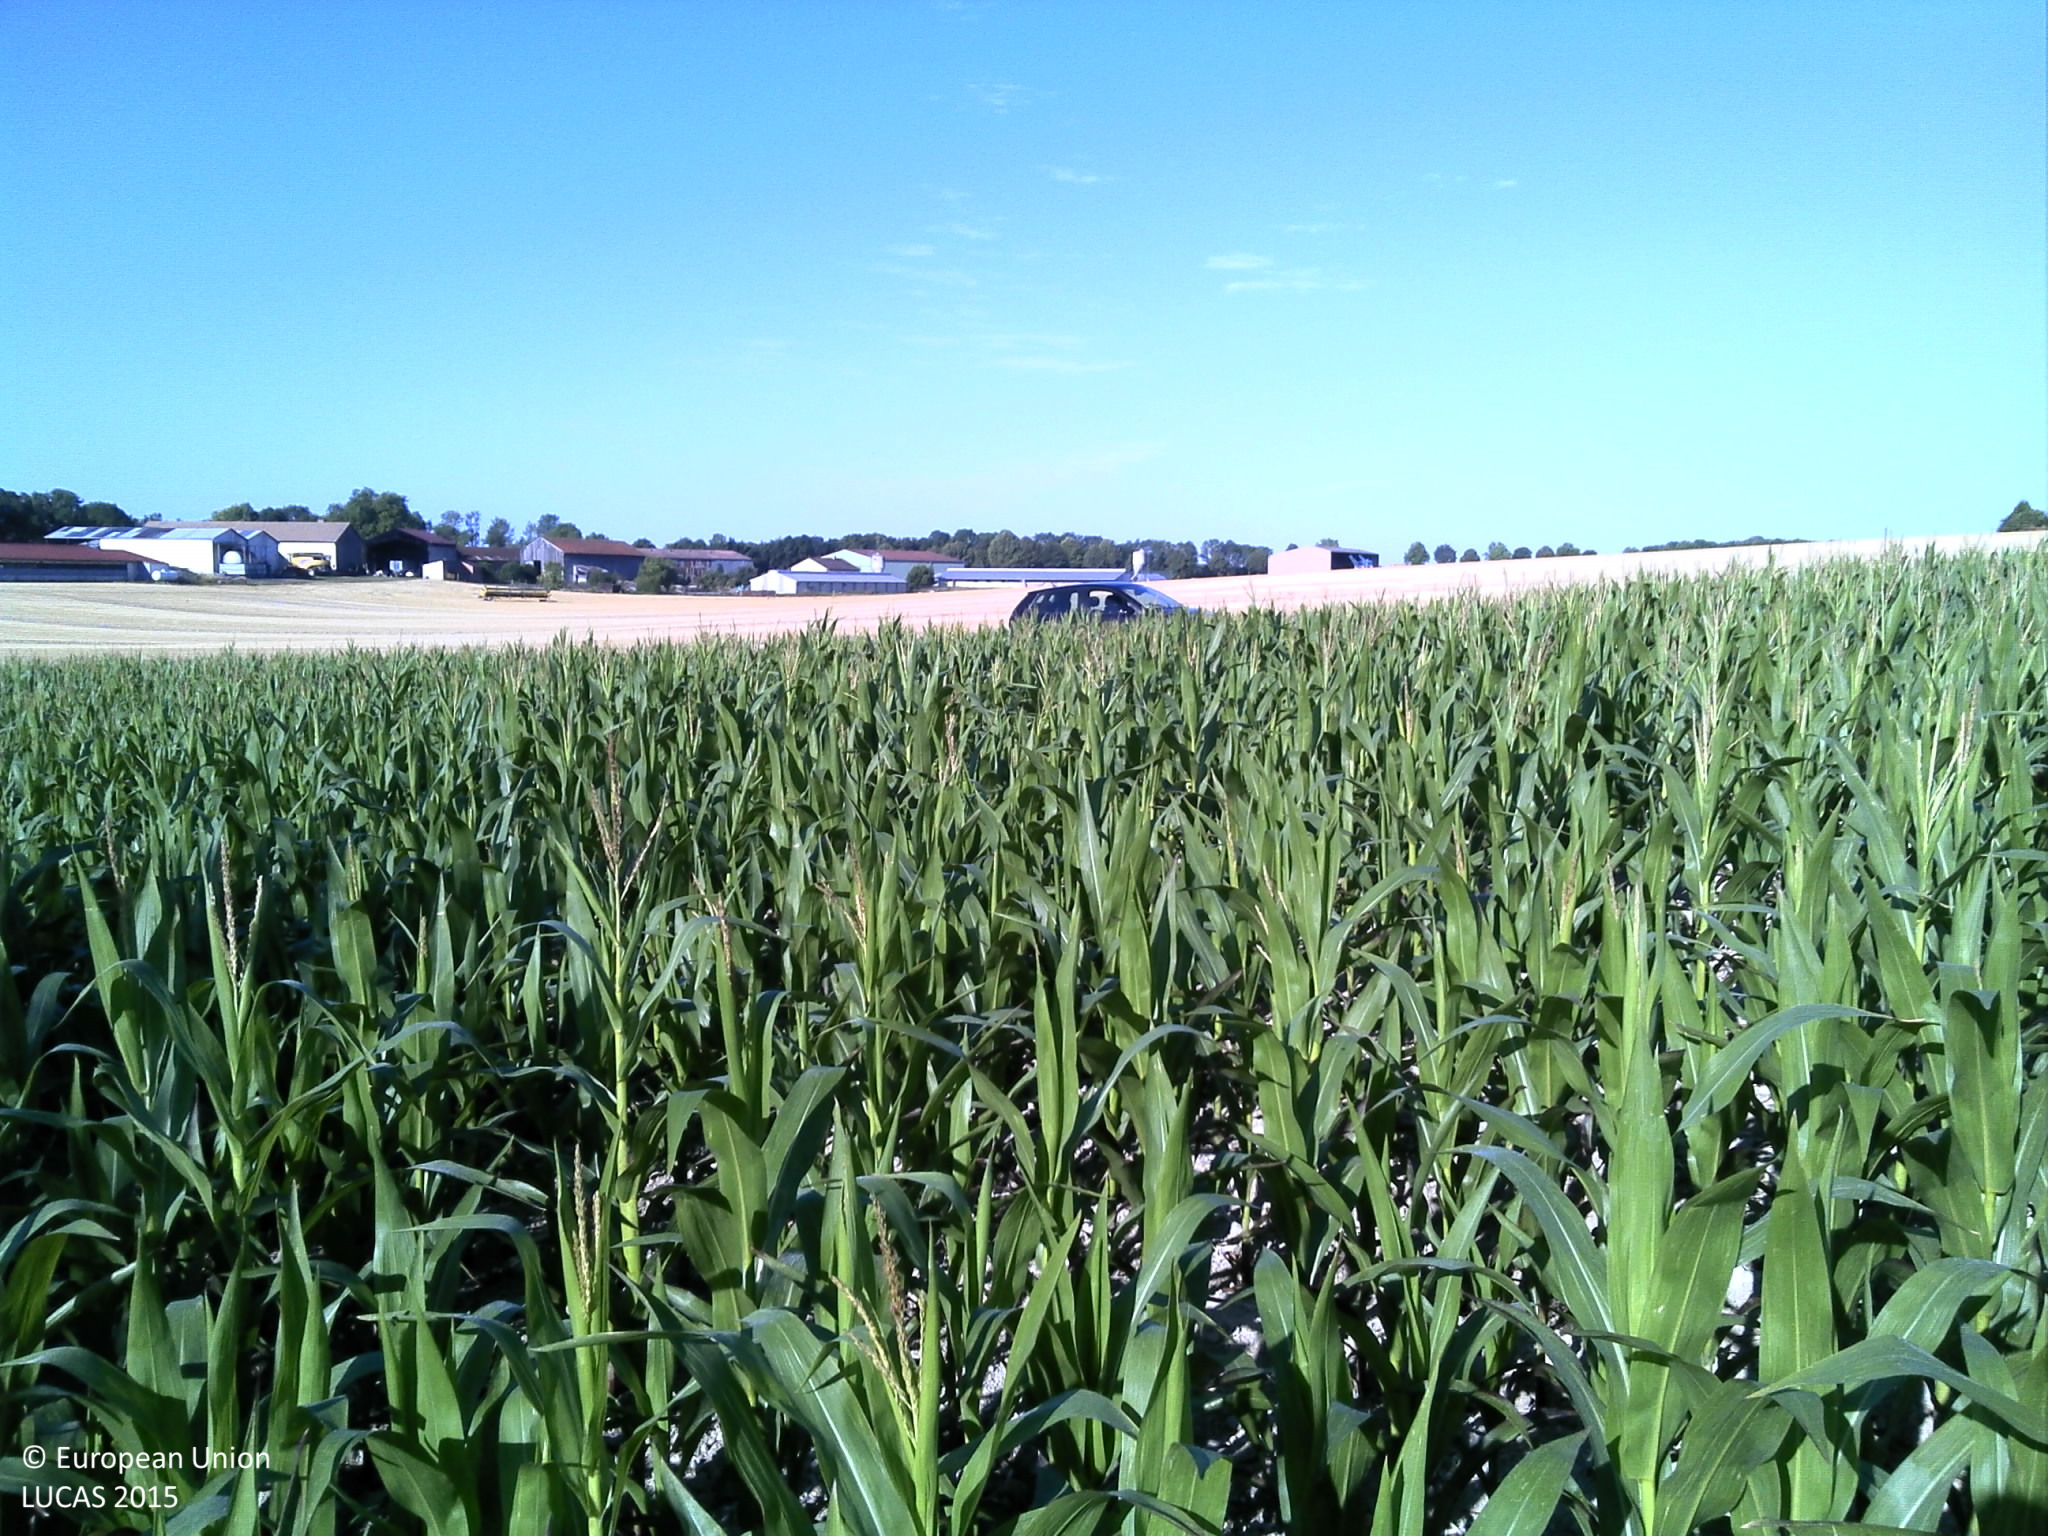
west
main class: Cropland
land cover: Maize
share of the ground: 50 - 75 %
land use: Agriculture (excluding fallow land and kitchen gardens)
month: August
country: FR
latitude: 49.1043
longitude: 4.6687
